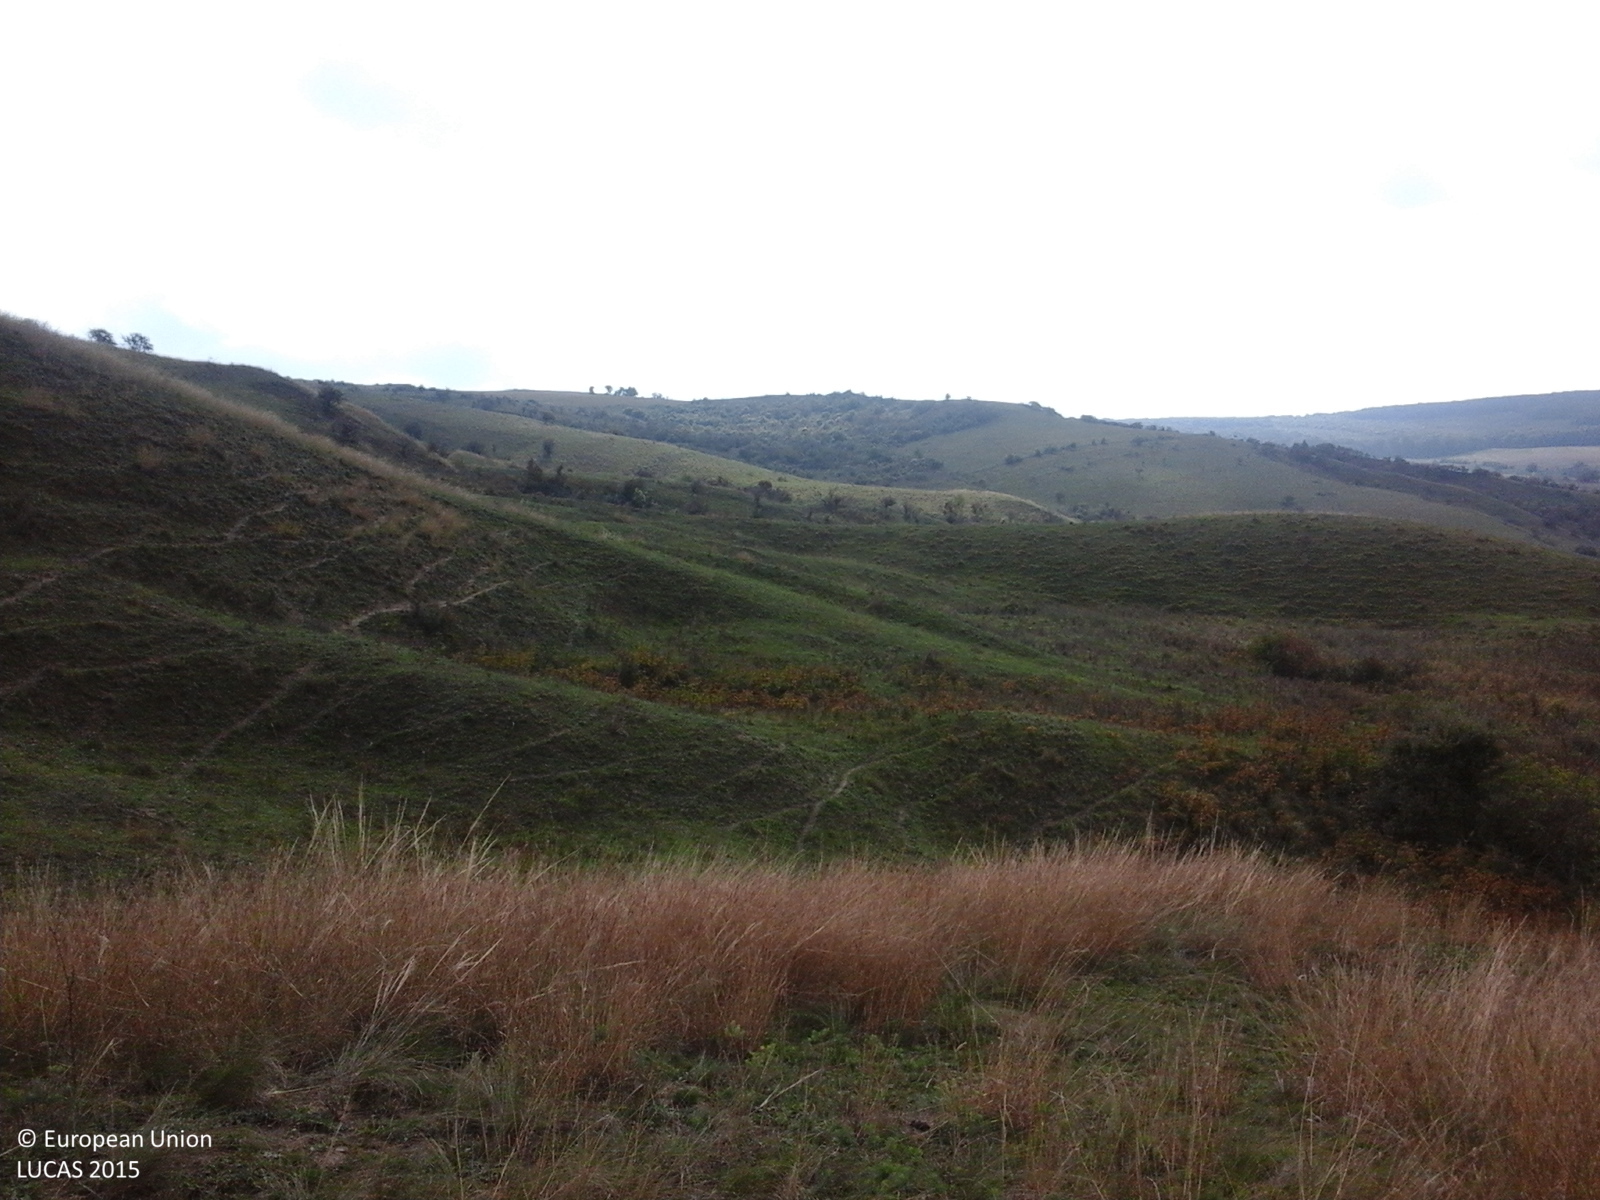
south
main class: Grassland
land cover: Grassland without tree/shrub cover
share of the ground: > 75 %
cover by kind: herbaceous plants 100 %
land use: Agriculture (excluding fallow land and kitchen gardens)
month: October
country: RO
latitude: 46.4245
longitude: 24.0393
